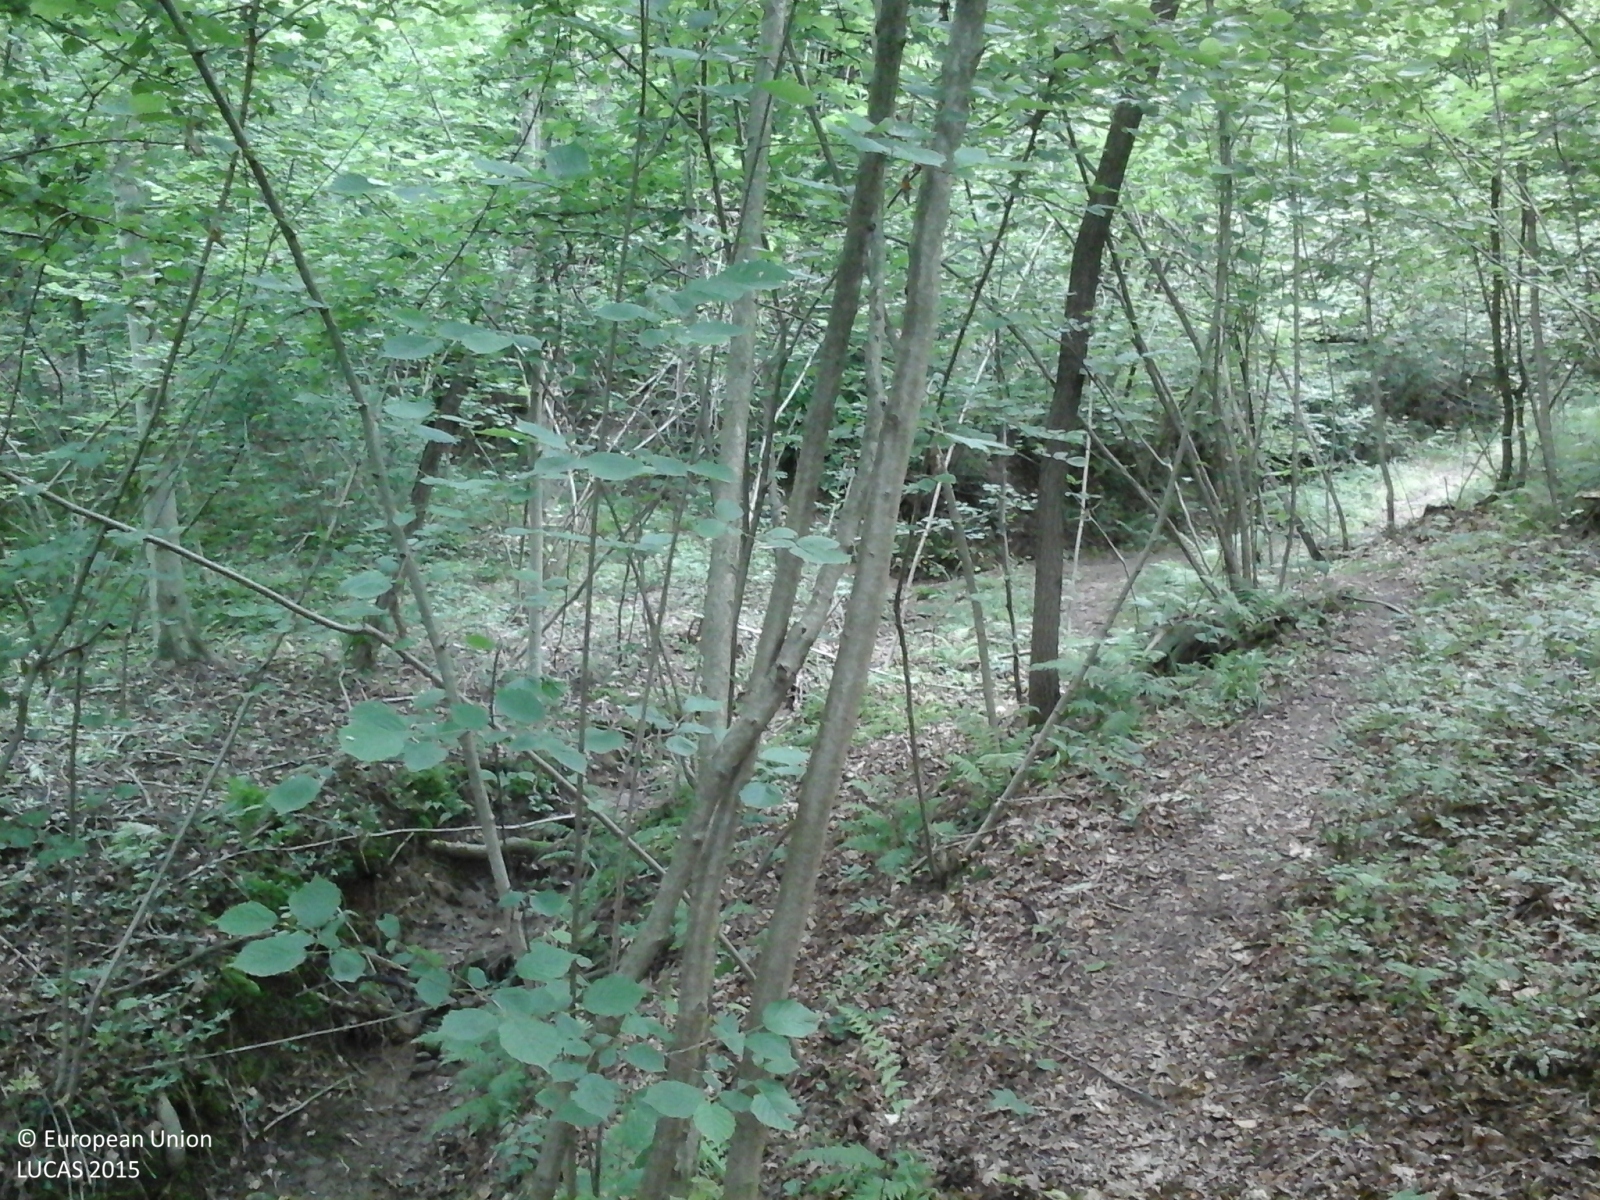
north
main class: Woodland
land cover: Broadleaved woodland
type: mesophytic deciduous forest
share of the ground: > 75 %
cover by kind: broadleaved forest trees 100 %
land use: Forestry
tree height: > 5 m
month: May
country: IT
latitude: 45.5791
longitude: 8.1958
